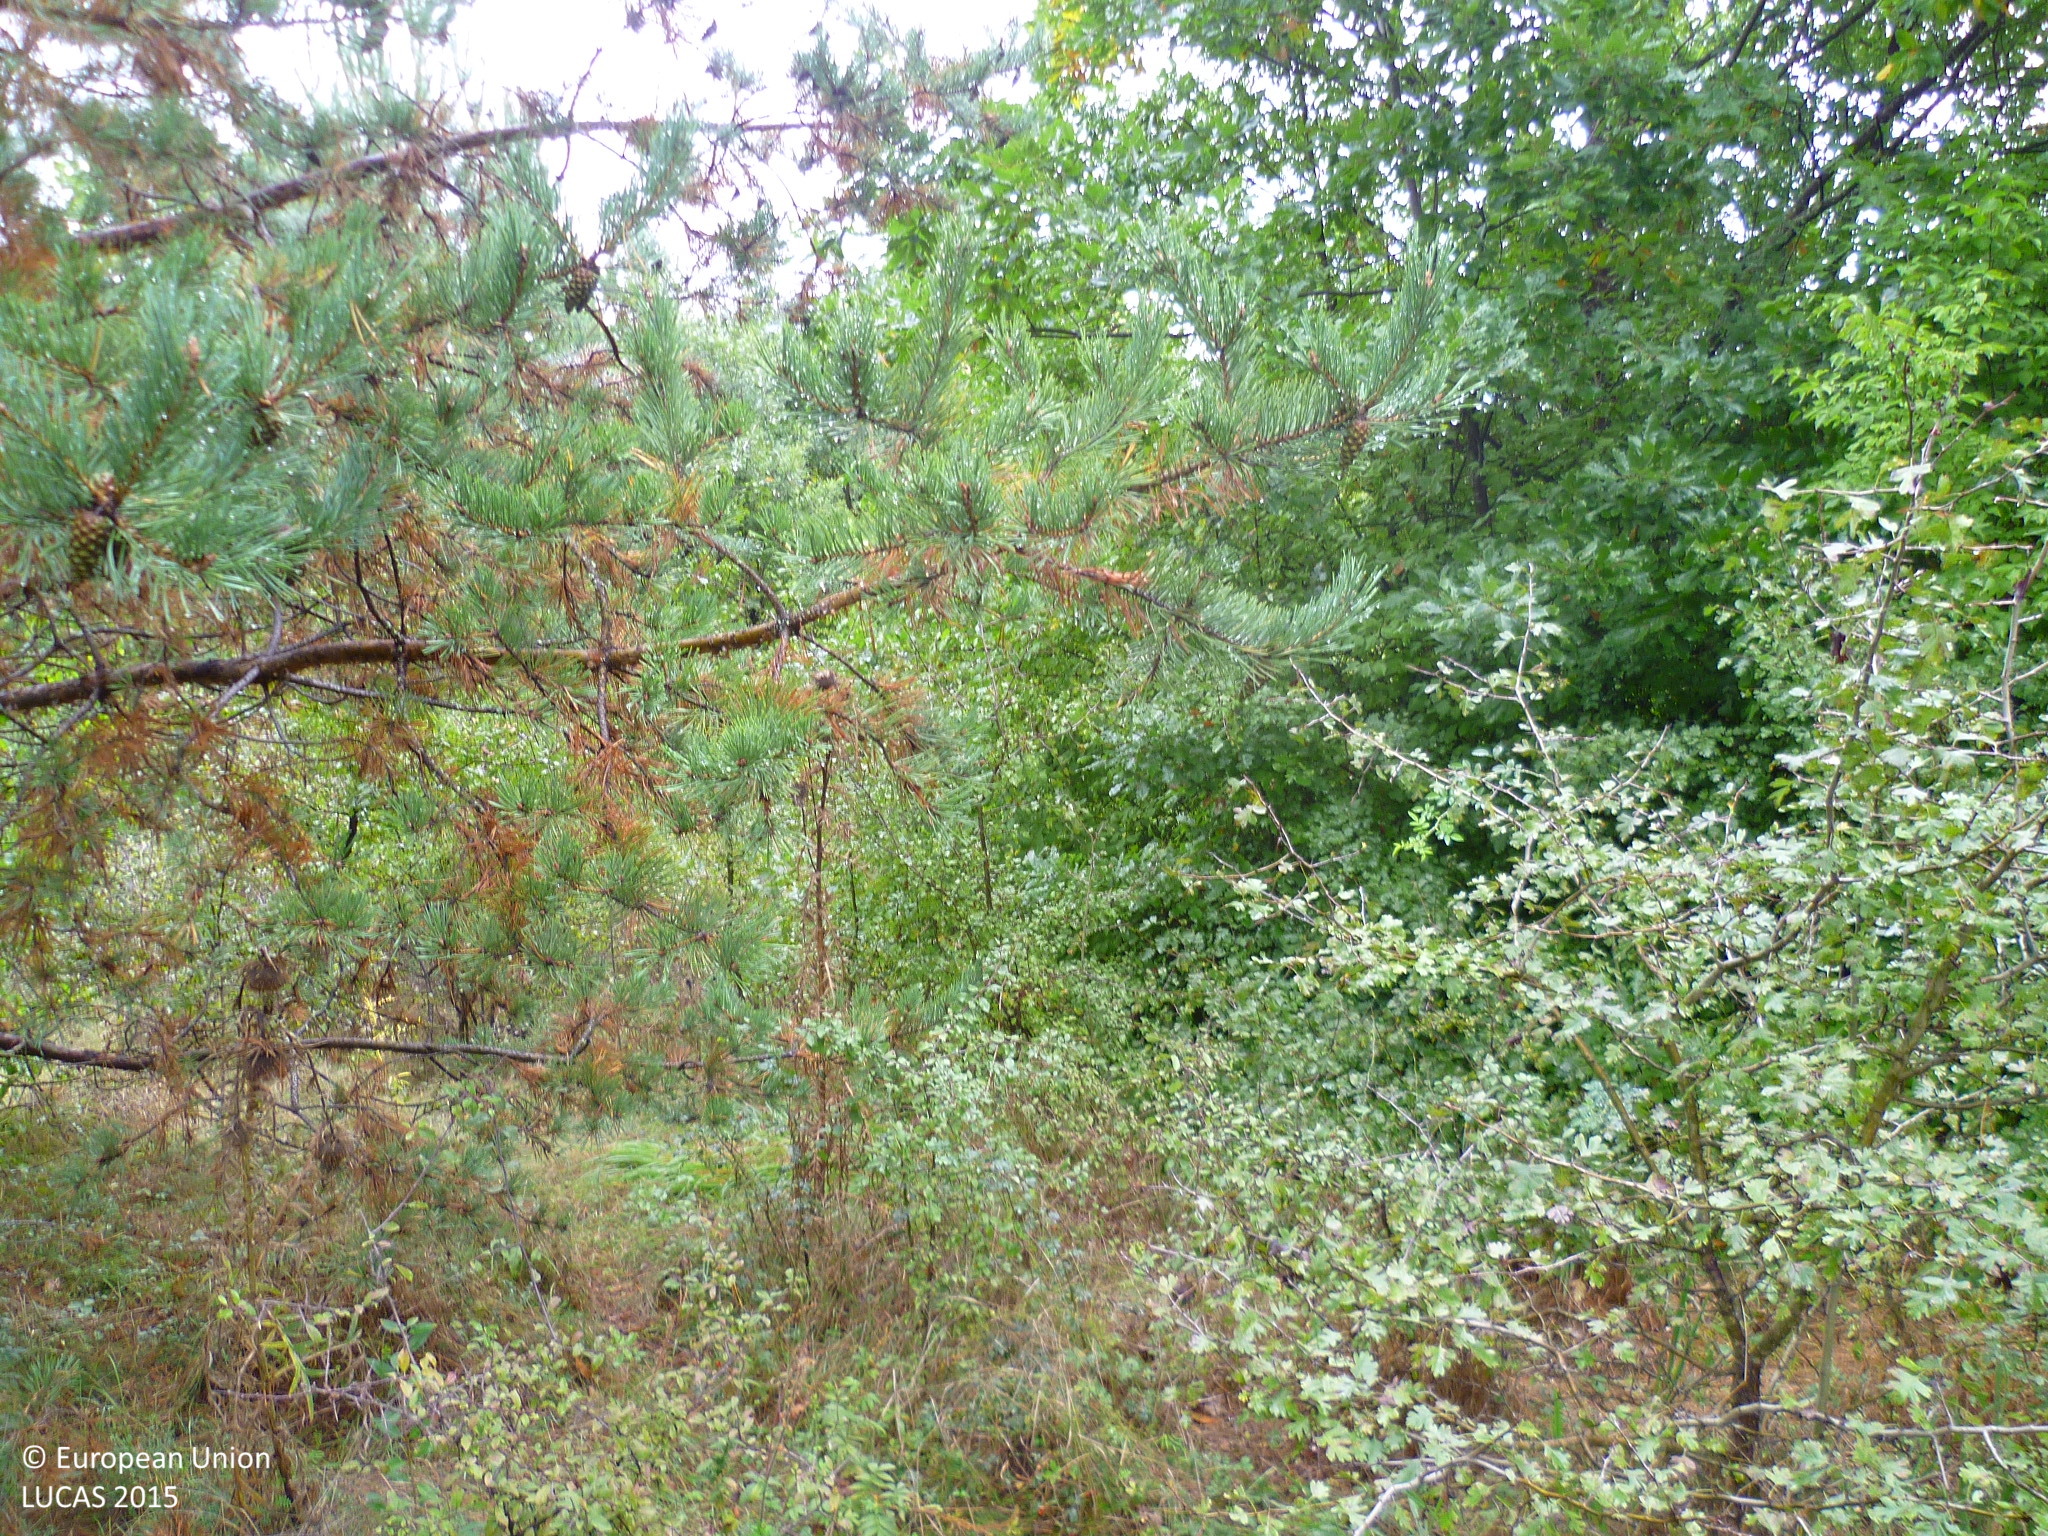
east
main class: Woodland
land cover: Pine dominated mixed woodland
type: hemiboreal forest and nemoral coniferous forest and mixed broadleaved-coniferous forest
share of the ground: > 75 %
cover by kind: coniferous forest trees 50 %, broadleaved forest trees 35 %, herbaceous plants 10 %, shrubs 5 %
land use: Forestry
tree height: > 5 m
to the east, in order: Pine dominated mixed woodland; Broadleaved woodland; Shrubland with sparse tree cover; Broadleaved woodland
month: September
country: BG
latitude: 42.6483
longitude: 22.7478
